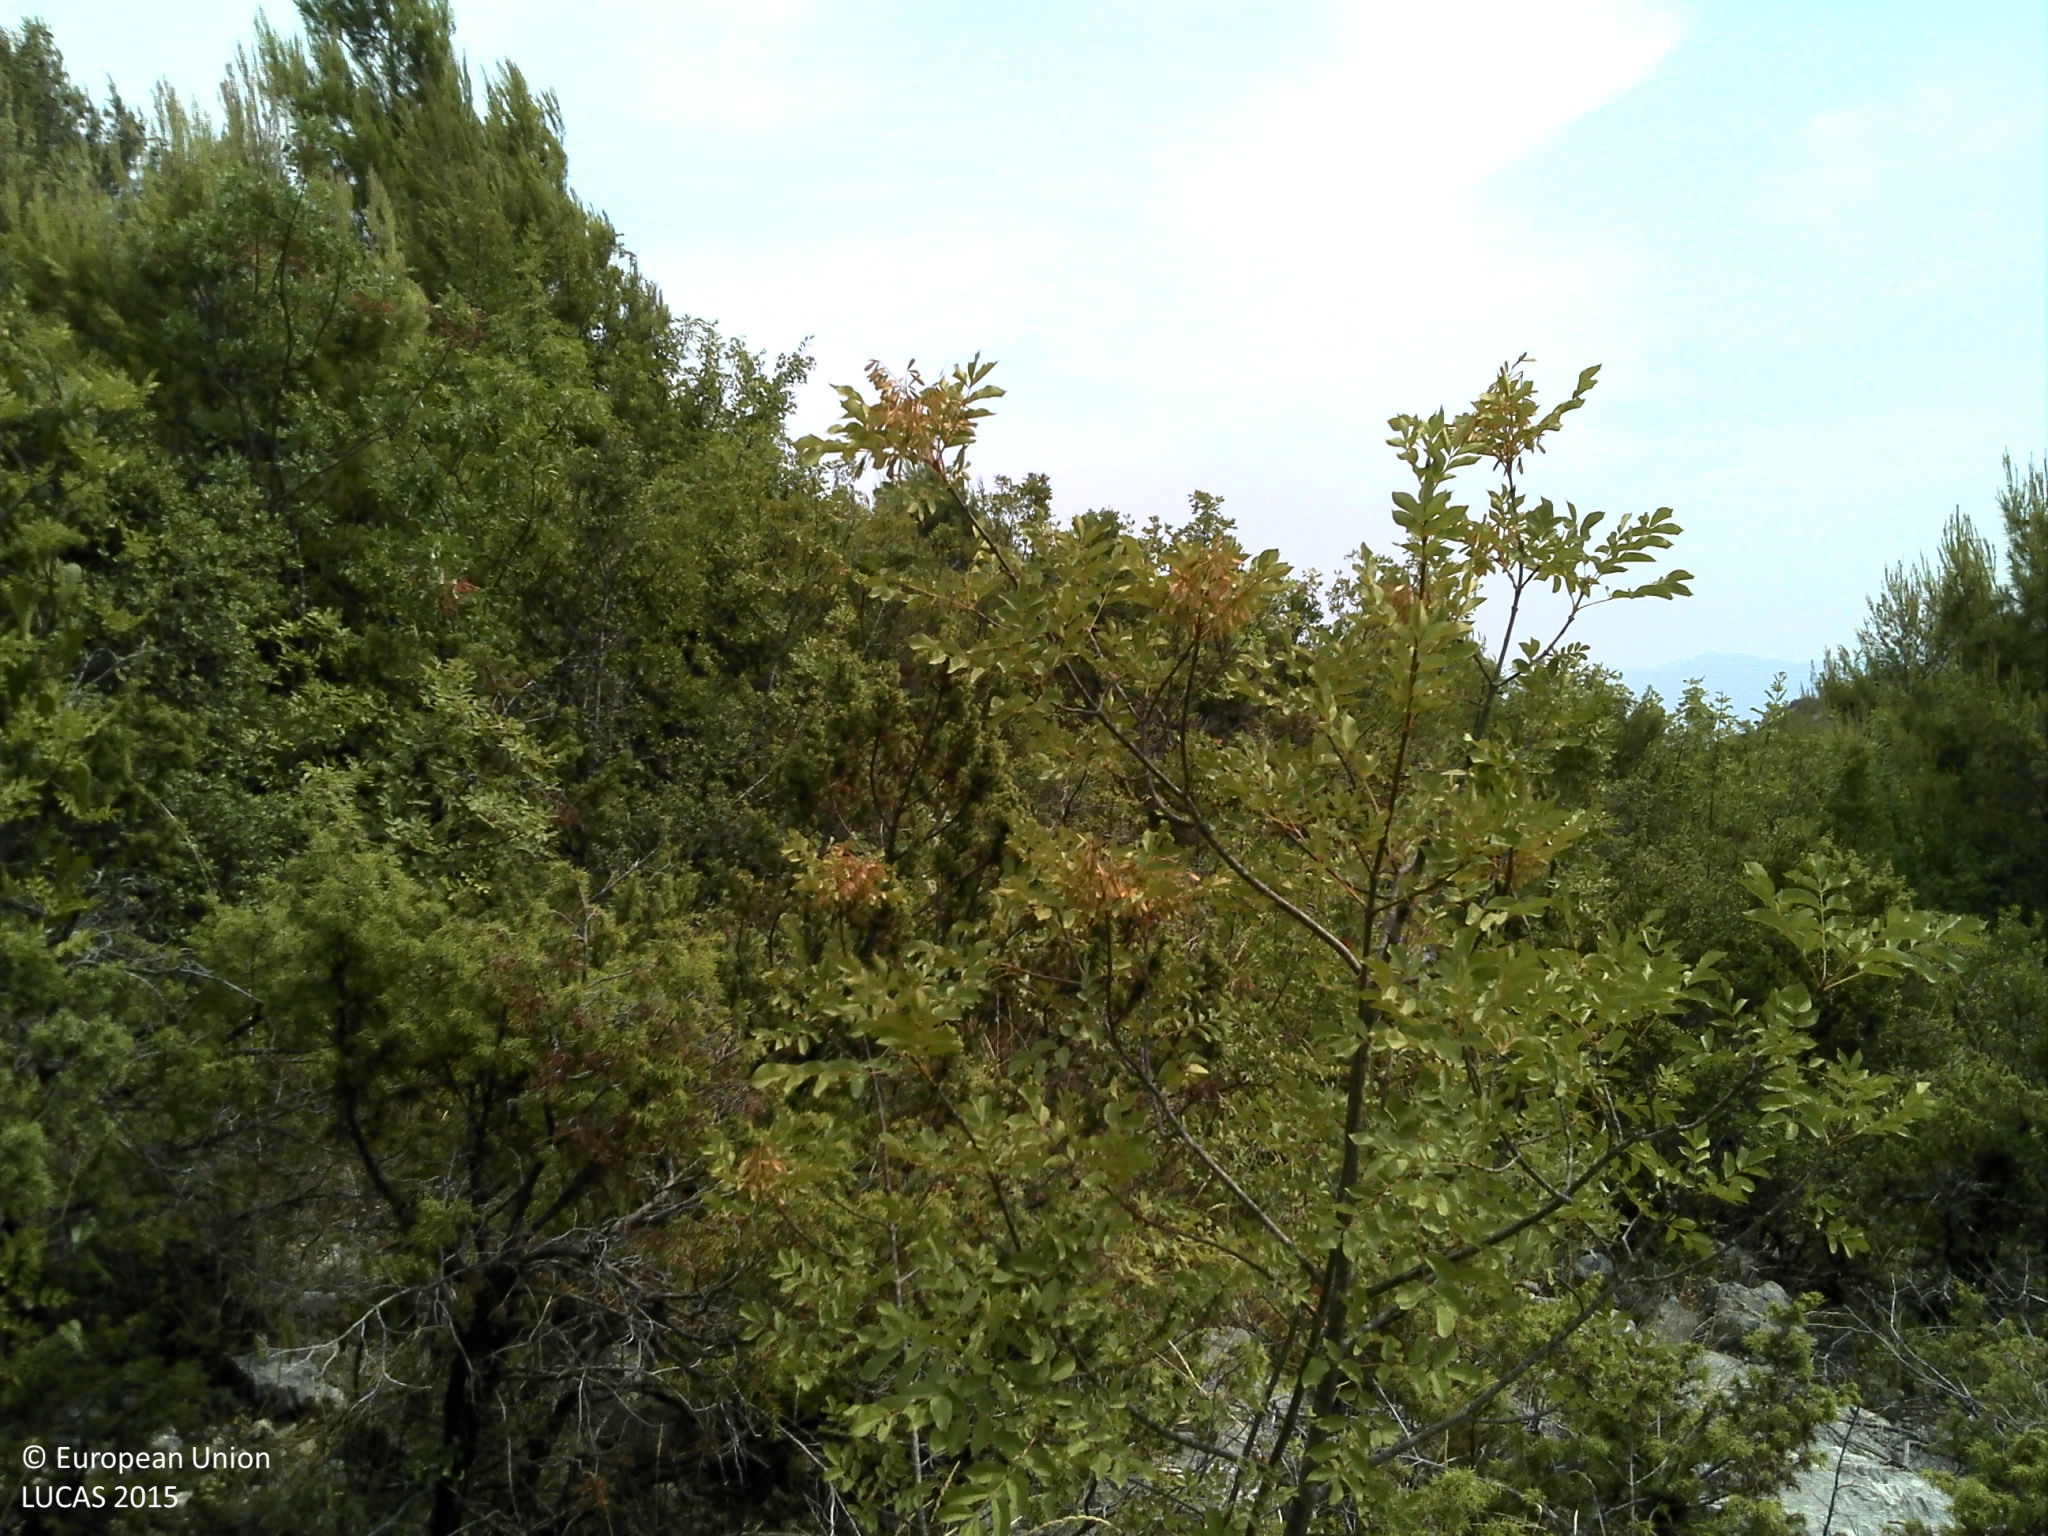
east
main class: Woodland
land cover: Pine dominated mixed woodland
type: coniferous forest of the mediterranean region
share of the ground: 50 - 75 %
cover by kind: coniferous forest trees 40 %, broadleaved forest trees 20 %, shrubs 20 %, consolidated bare surface 20 %
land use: Abandoned areas
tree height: > 5 m
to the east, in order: Pine dominated mixed woodland; Dry stone walls; Shrubland with sparse tree cover; Dry stone walls; Pine dominated mixed woodland
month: August
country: HR
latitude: 43.0936
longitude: 17.5958
